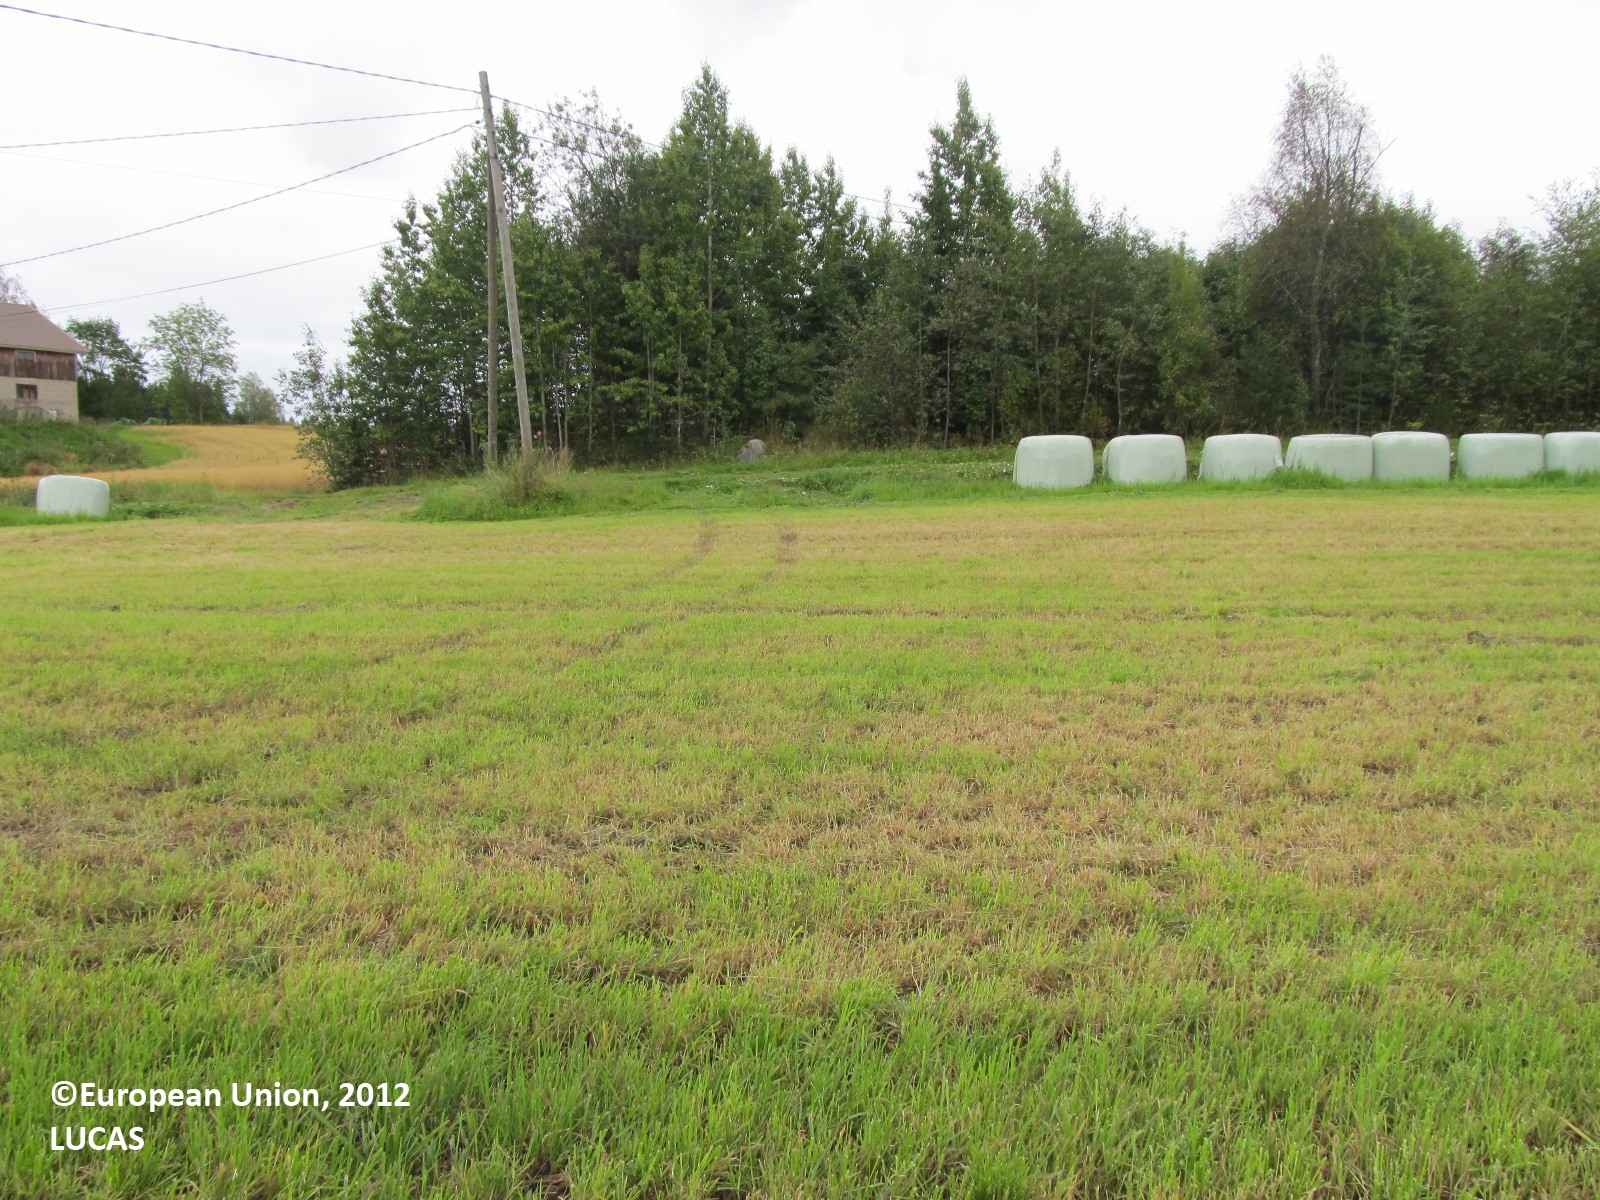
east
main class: Cropland
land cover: Temporary grasslands
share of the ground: 50 - 75 %
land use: Agriculture (excluding fallow land and kitchen gardens)
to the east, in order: Temporary grasslands; Tracks; Oats; Artificial constructions in urban areas; Oats; Ditches and canals; Paved roads, cycling and walking lanes; Ditches and canals; Temporary grasslands
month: August
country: FI
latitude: 63.1757
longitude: 27.6232
